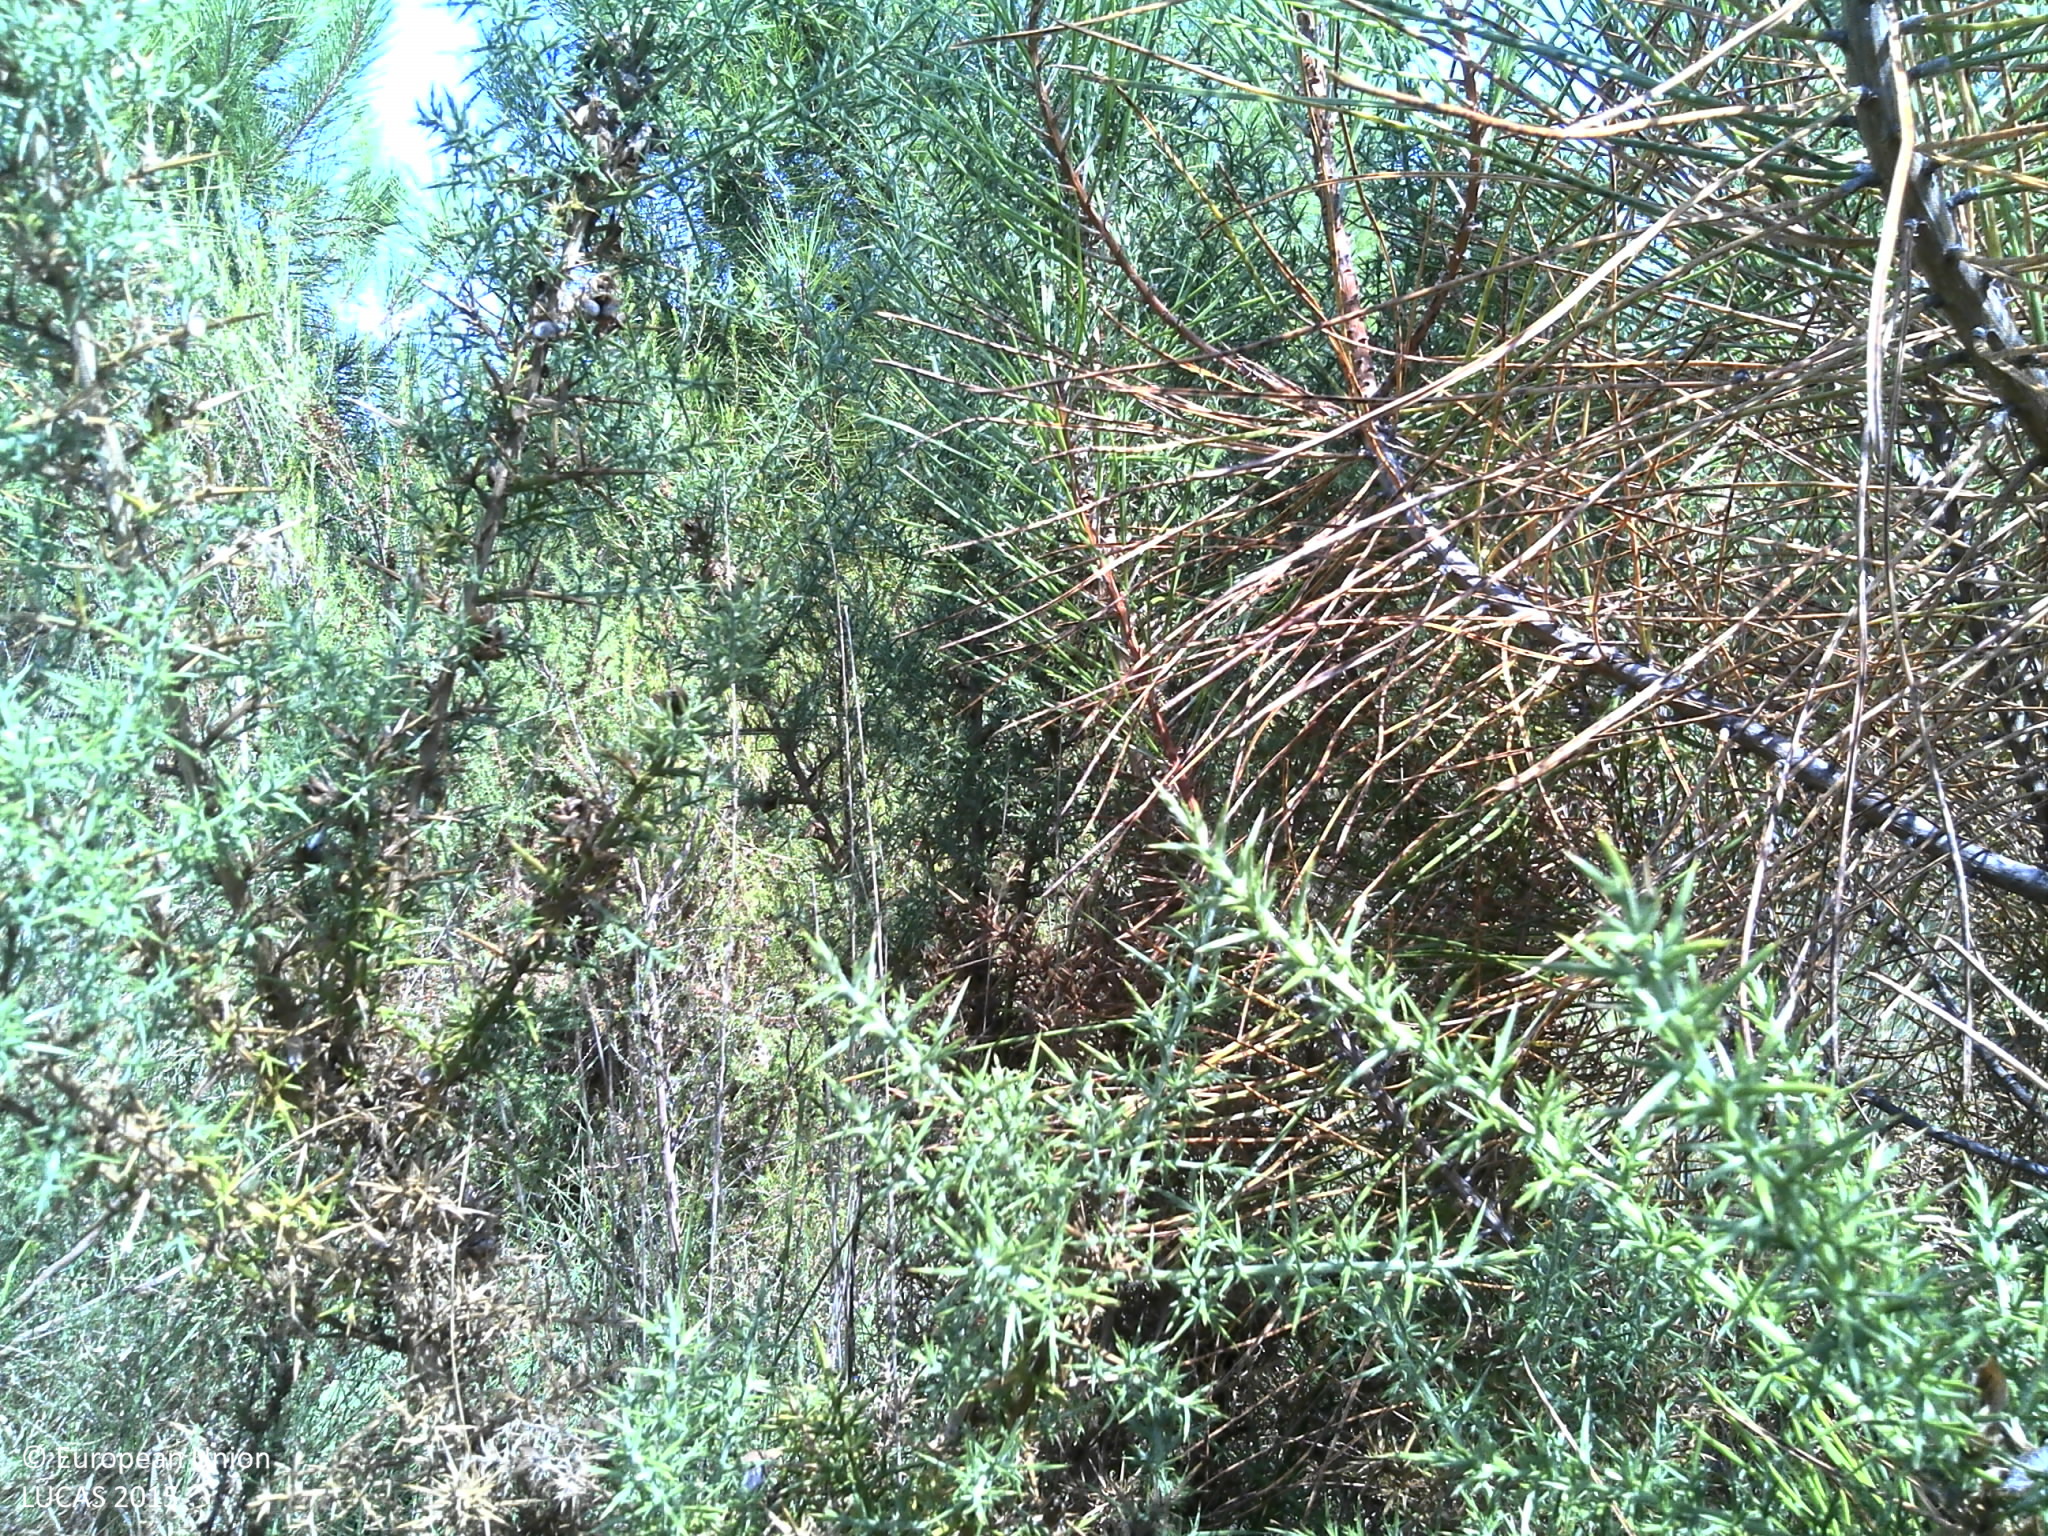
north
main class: Woodland
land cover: Pine dominated coniferous woodland
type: coniferous forest of the mediterranean region
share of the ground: > 75 %
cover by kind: coniferous forest trees 60 %, shrubs 30 %, herbaceous plants 5 %, lichens and mosses 5 %
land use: Forestry
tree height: > 5 m
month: August
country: FR
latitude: 45.0311
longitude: -1.0544
